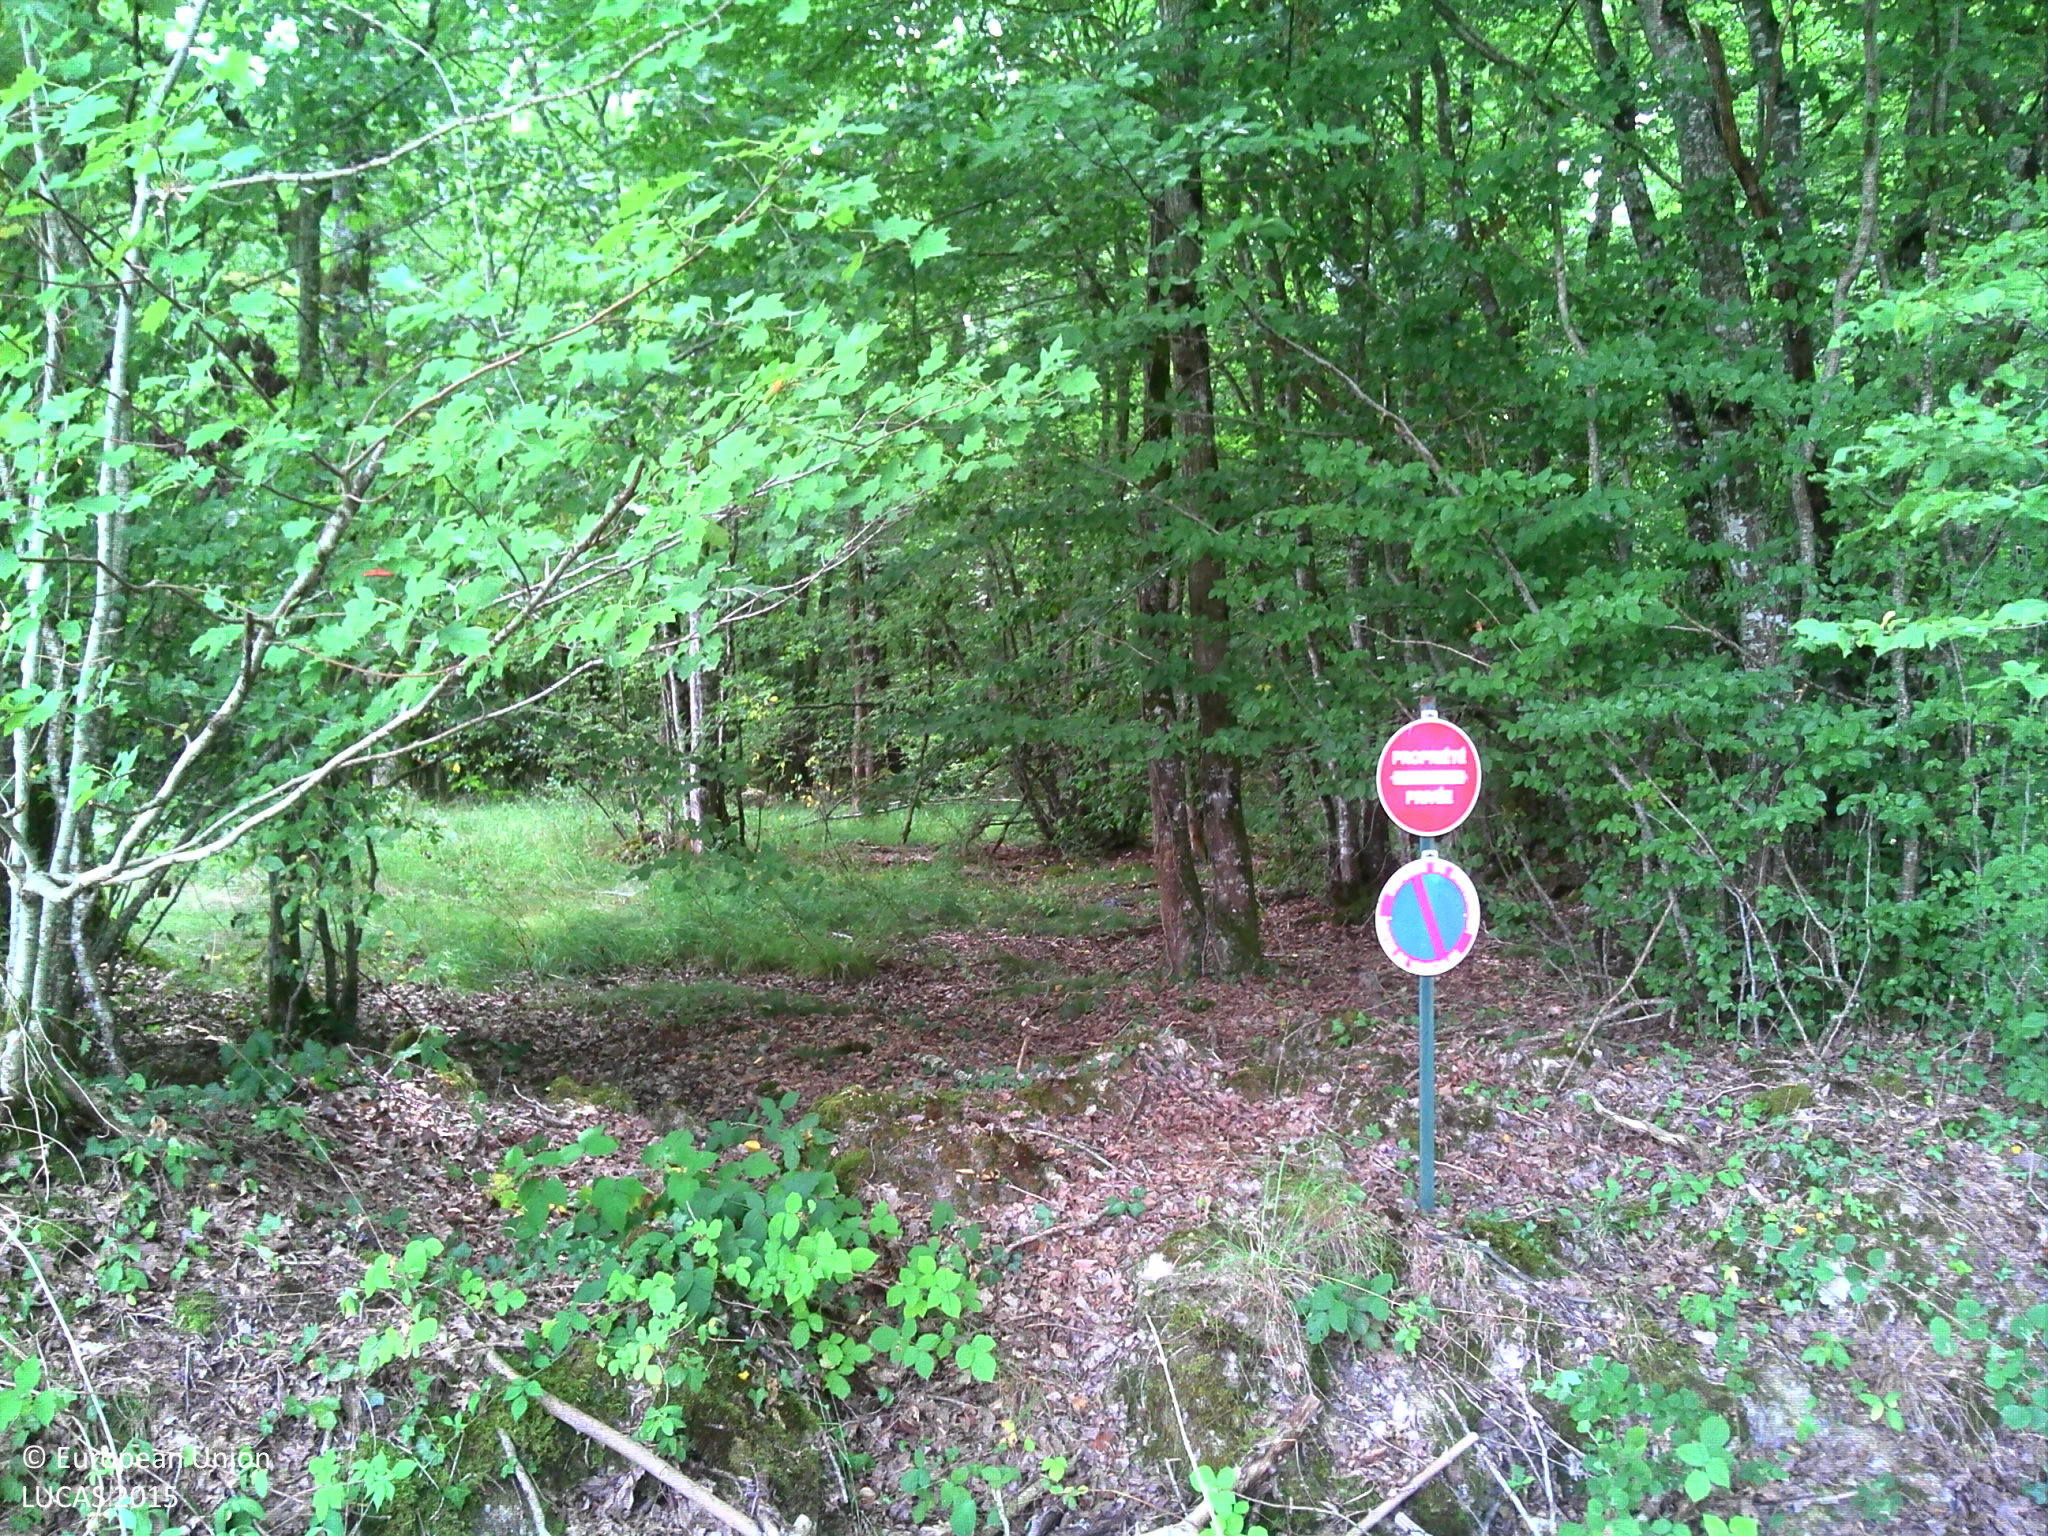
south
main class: Woodland
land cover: Broadleaved woodland
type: mesophytic deciduous forest
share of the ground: > 75 %
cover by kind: broadleaved forest trees 90 %, shrubs 5 %, herbaceous plants 5 %
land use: Forestry
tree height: > 5 m
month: July
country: FR
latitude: 46.6430
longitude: 2.9548
